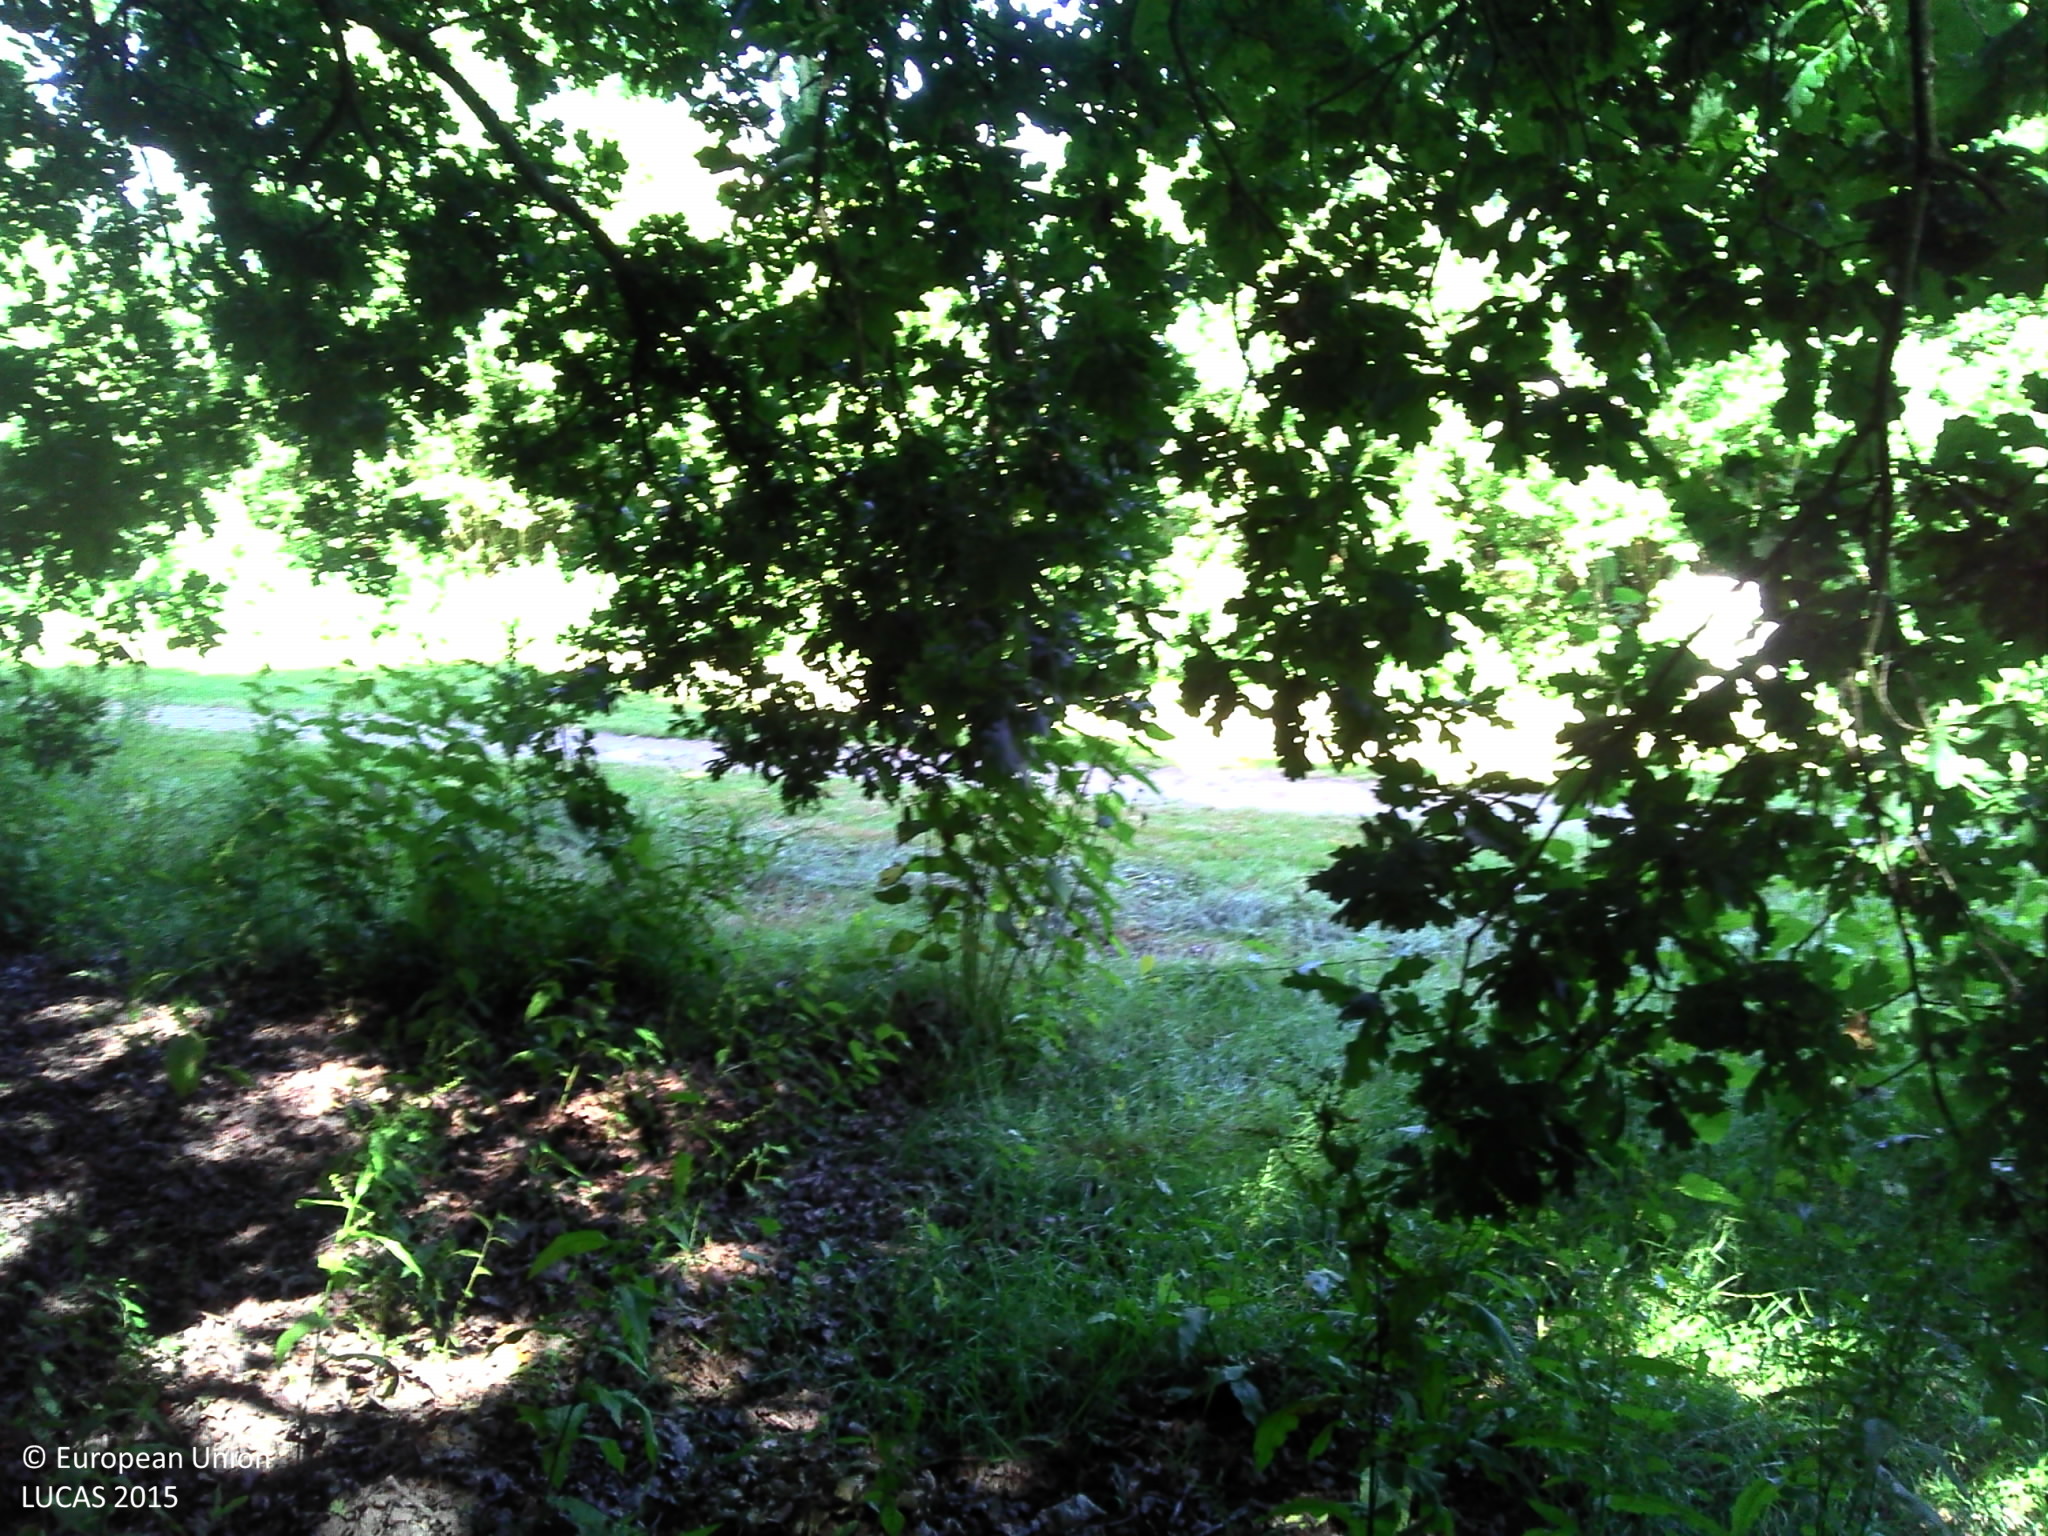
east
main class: Woodland
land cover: Broadleaved woodland
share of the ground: > 75 %
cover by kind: broadleaved forest trees 90 %, herbaceous plants 10 %
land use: Sport
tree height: > 5 m
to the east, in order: Broadleaved woodland; Grassland without tree/shrub cover; Tracks; Grassland without tree/shrub cover; Managed hedges; Ditches and canals; Broadleaved woodland; Artificial constructions in urban areas; Grassland without tree/shrub cover; Lines of trees; Grassland without tree/shrub cover; Lines of trees; Grass margins; Tracks; Grassland without tree/shrub cover; Abandoned hedges; Grassland without tree/shrub cover
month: June
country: FR
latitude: 48.0370
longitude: -1.6760
